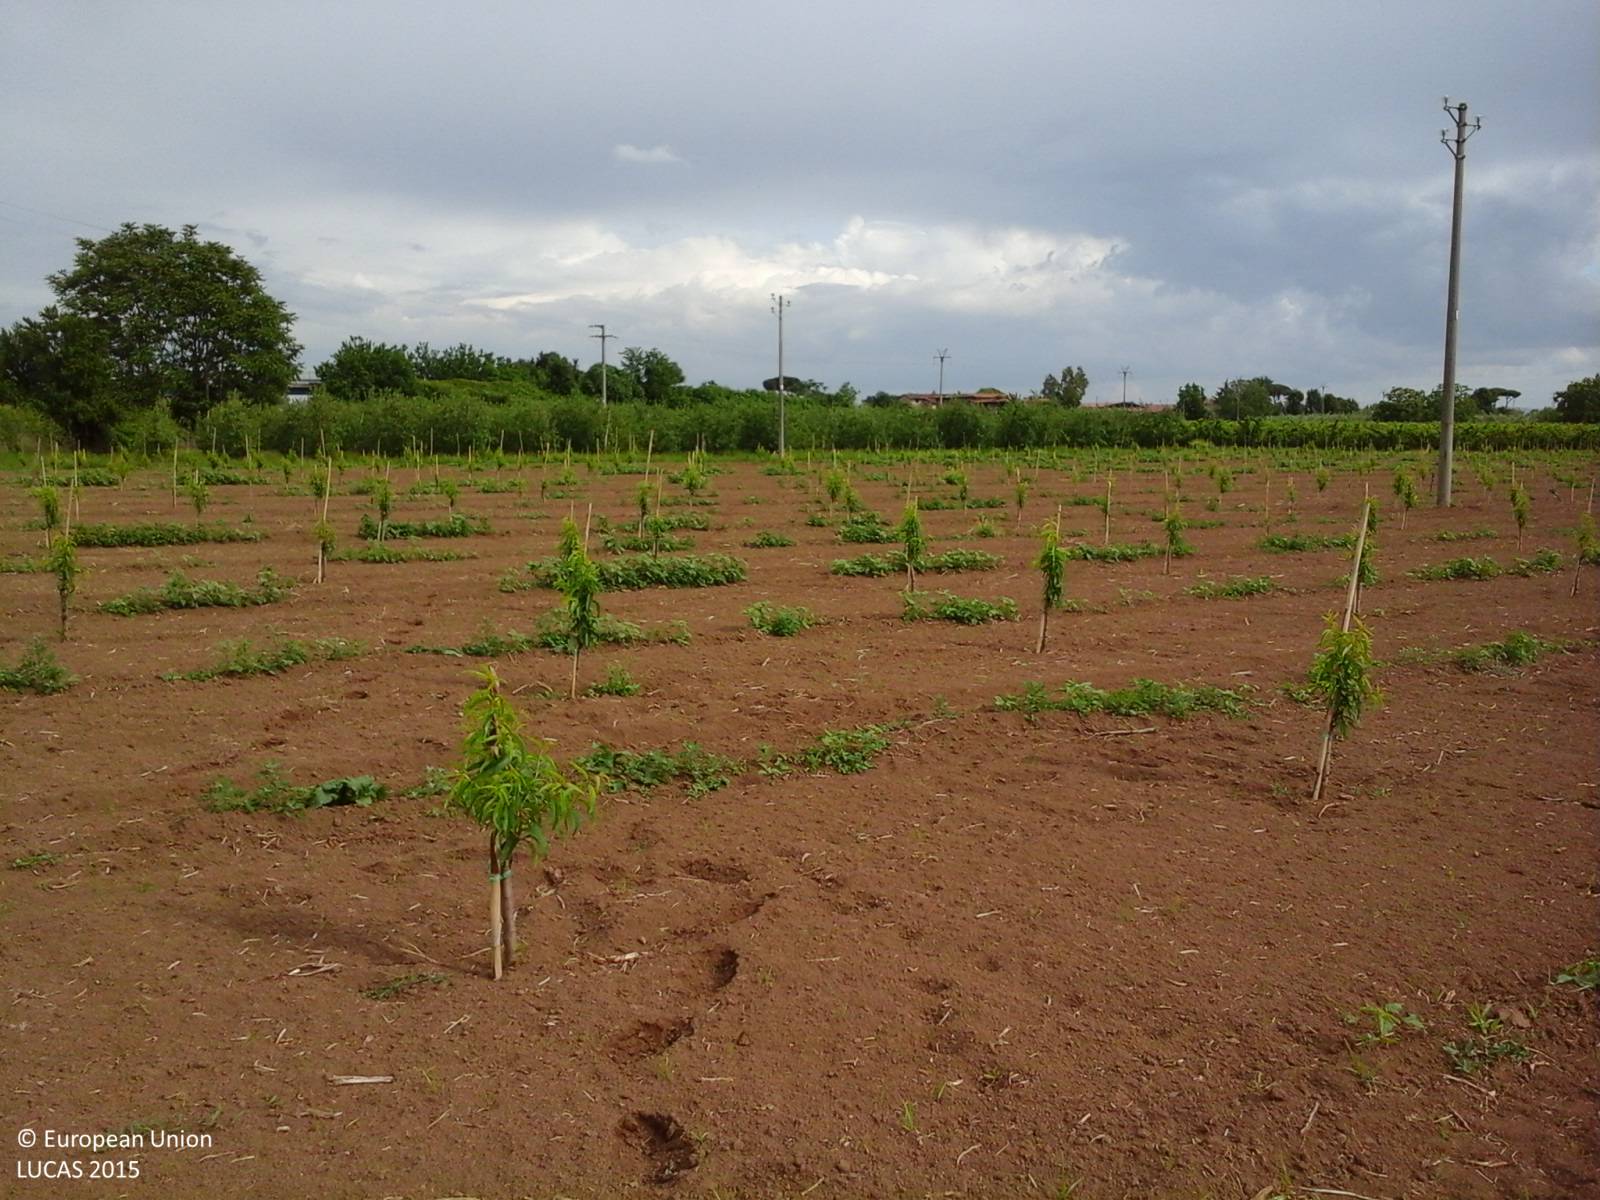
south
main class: Cropland
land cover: Other fruit trees and berries
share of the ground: < 10 %
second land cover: Other bare soil
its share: > 75 %
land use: Agriculture (excluding fallow land and kitchen gardens)
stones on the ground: < 10 %
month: May
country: IT
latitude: 41.1751
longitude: 14.1675
